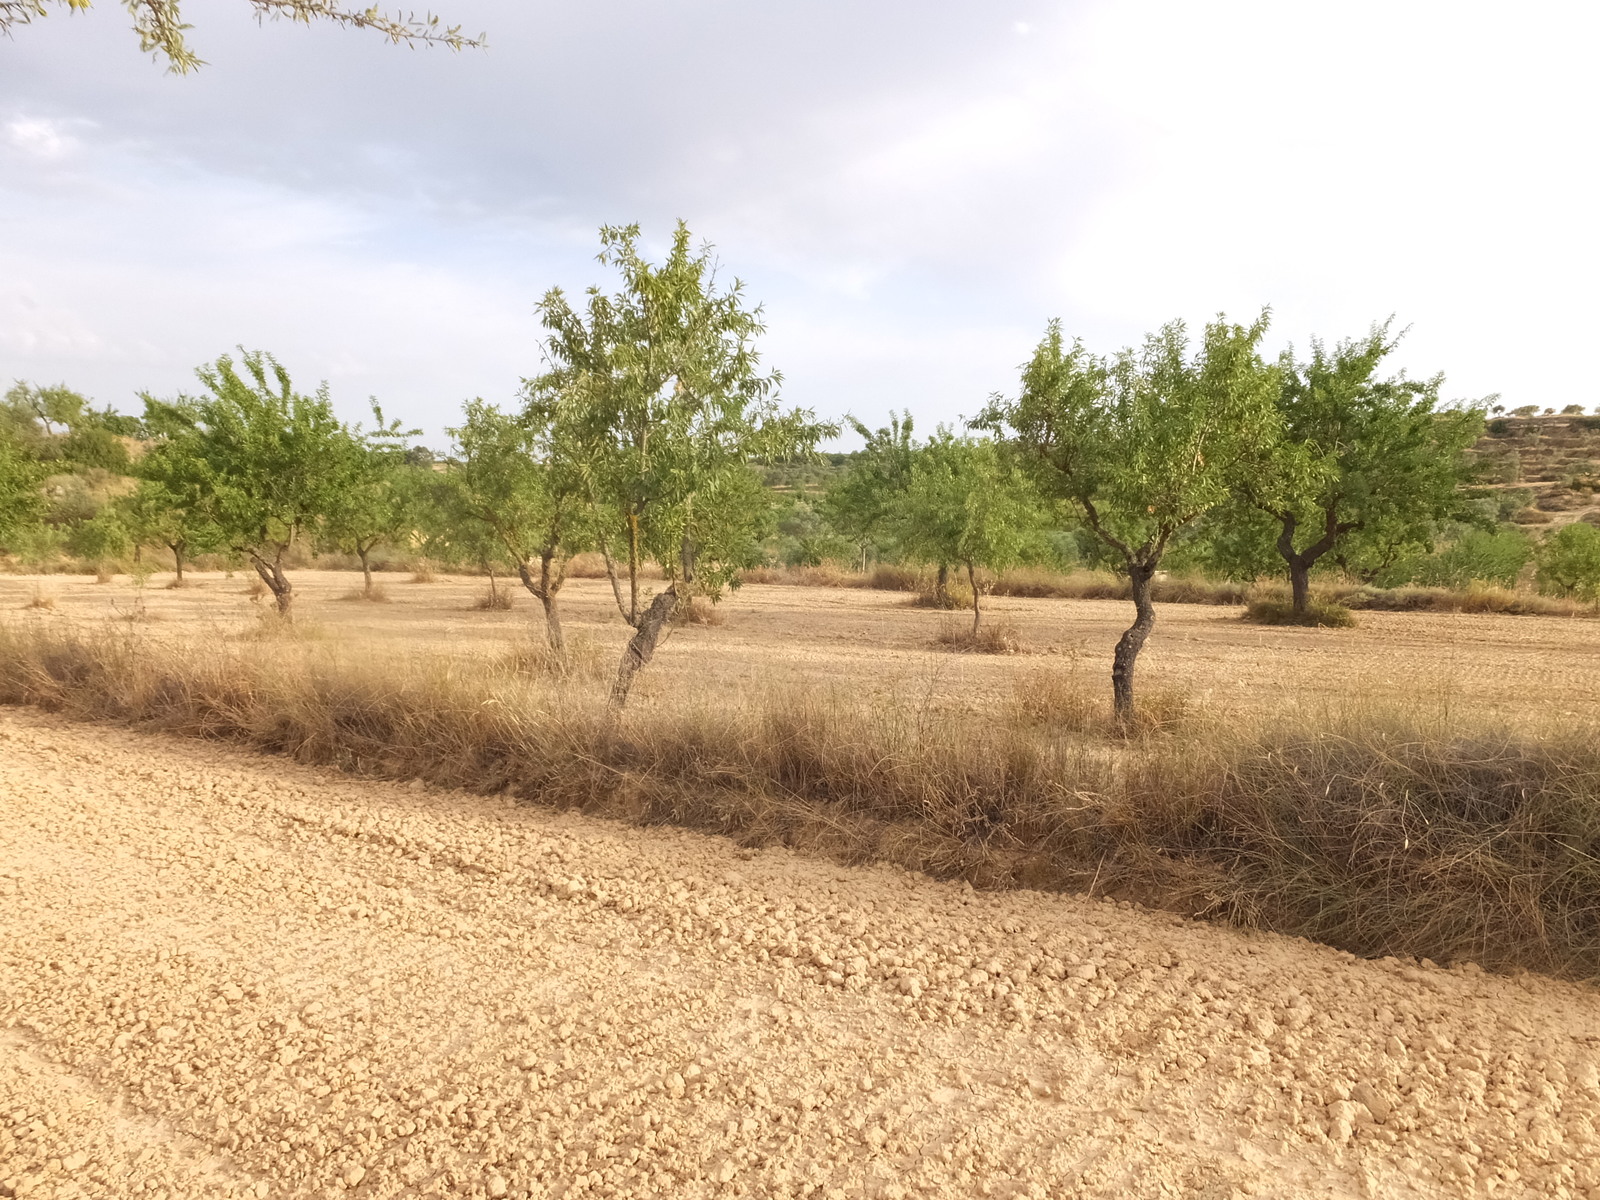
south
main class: Cropland
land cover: Nuts trees
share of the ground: 50 - 75 %
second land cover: Other bare soil
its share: > 75 %
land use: Agriculture (excluding fallow land and kitchen gardens)
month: July
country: ES
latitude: 41.3666
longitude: 0.4608
